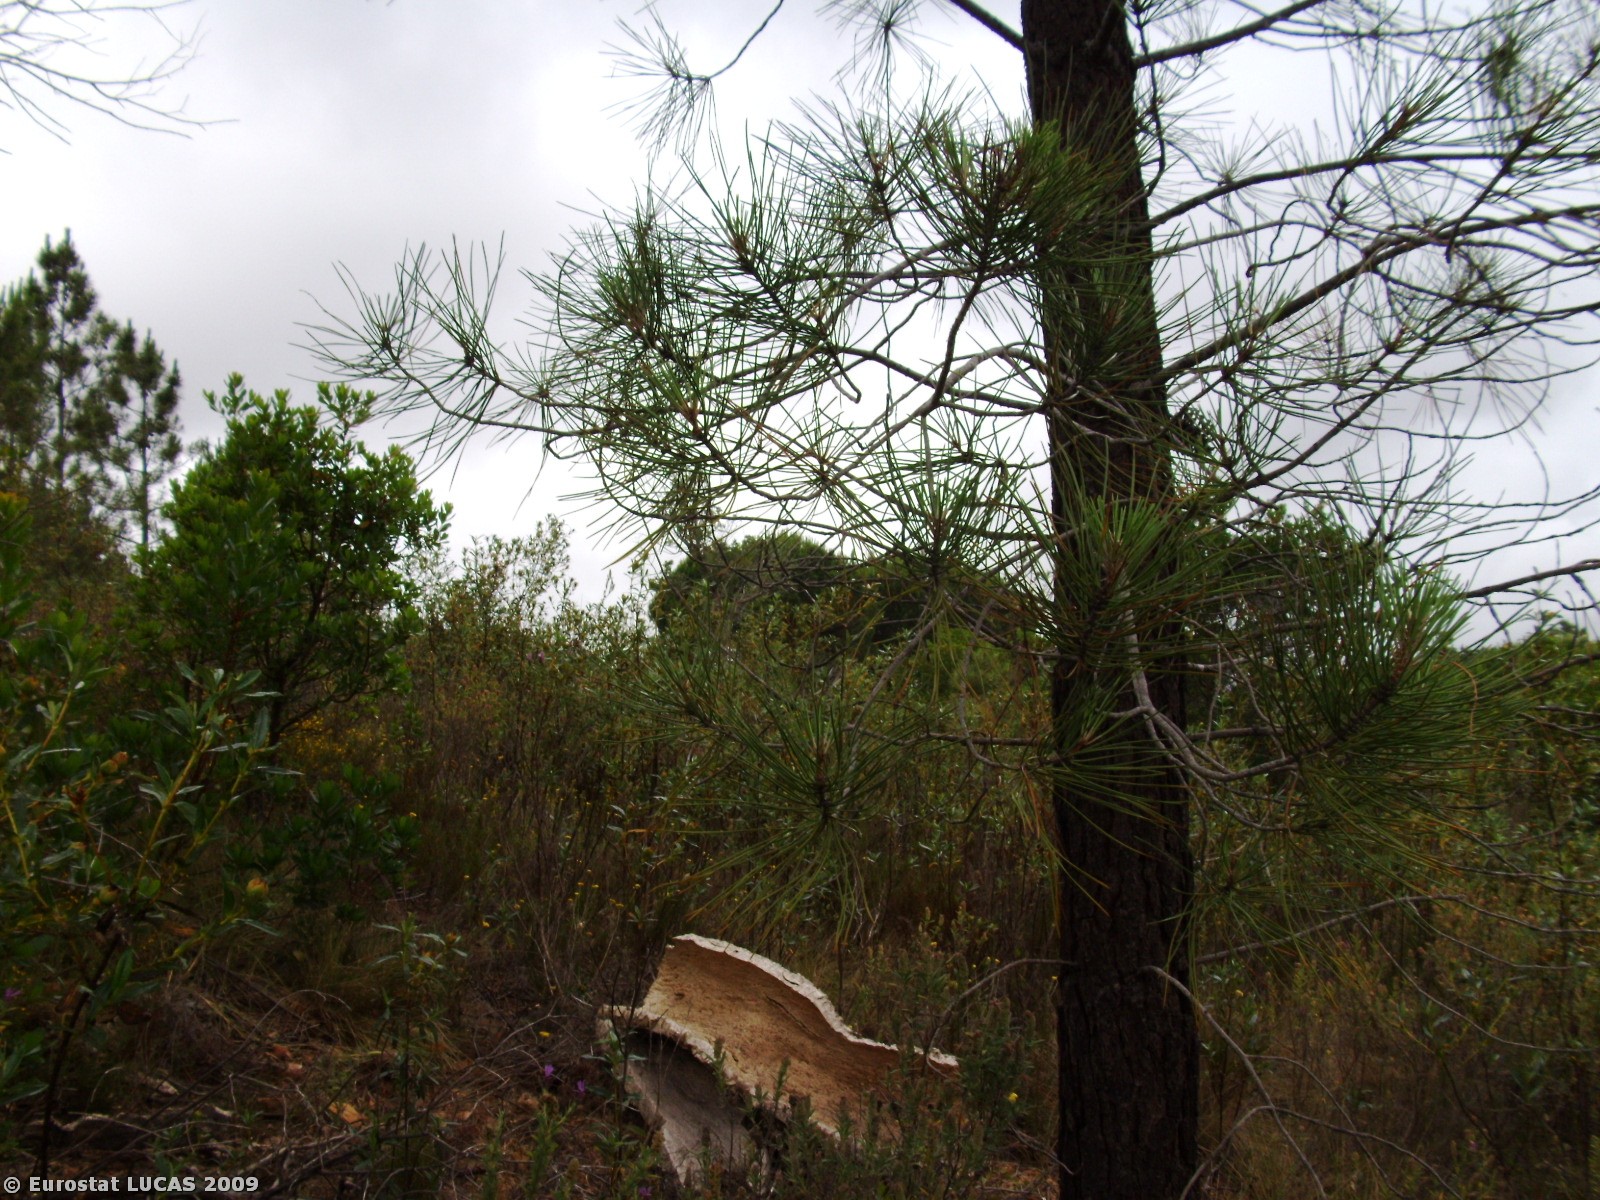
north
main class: Woodland
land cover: Coniferous woodland
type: coniferous forest of the mediterranean region
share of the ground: 10 - 25 %
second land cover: Shrubland with sparse tree cover
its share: 50 - 75 %
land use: Forestry
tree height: > 5 m
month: June
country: PT
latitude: 37.1829
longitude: -8.8336
